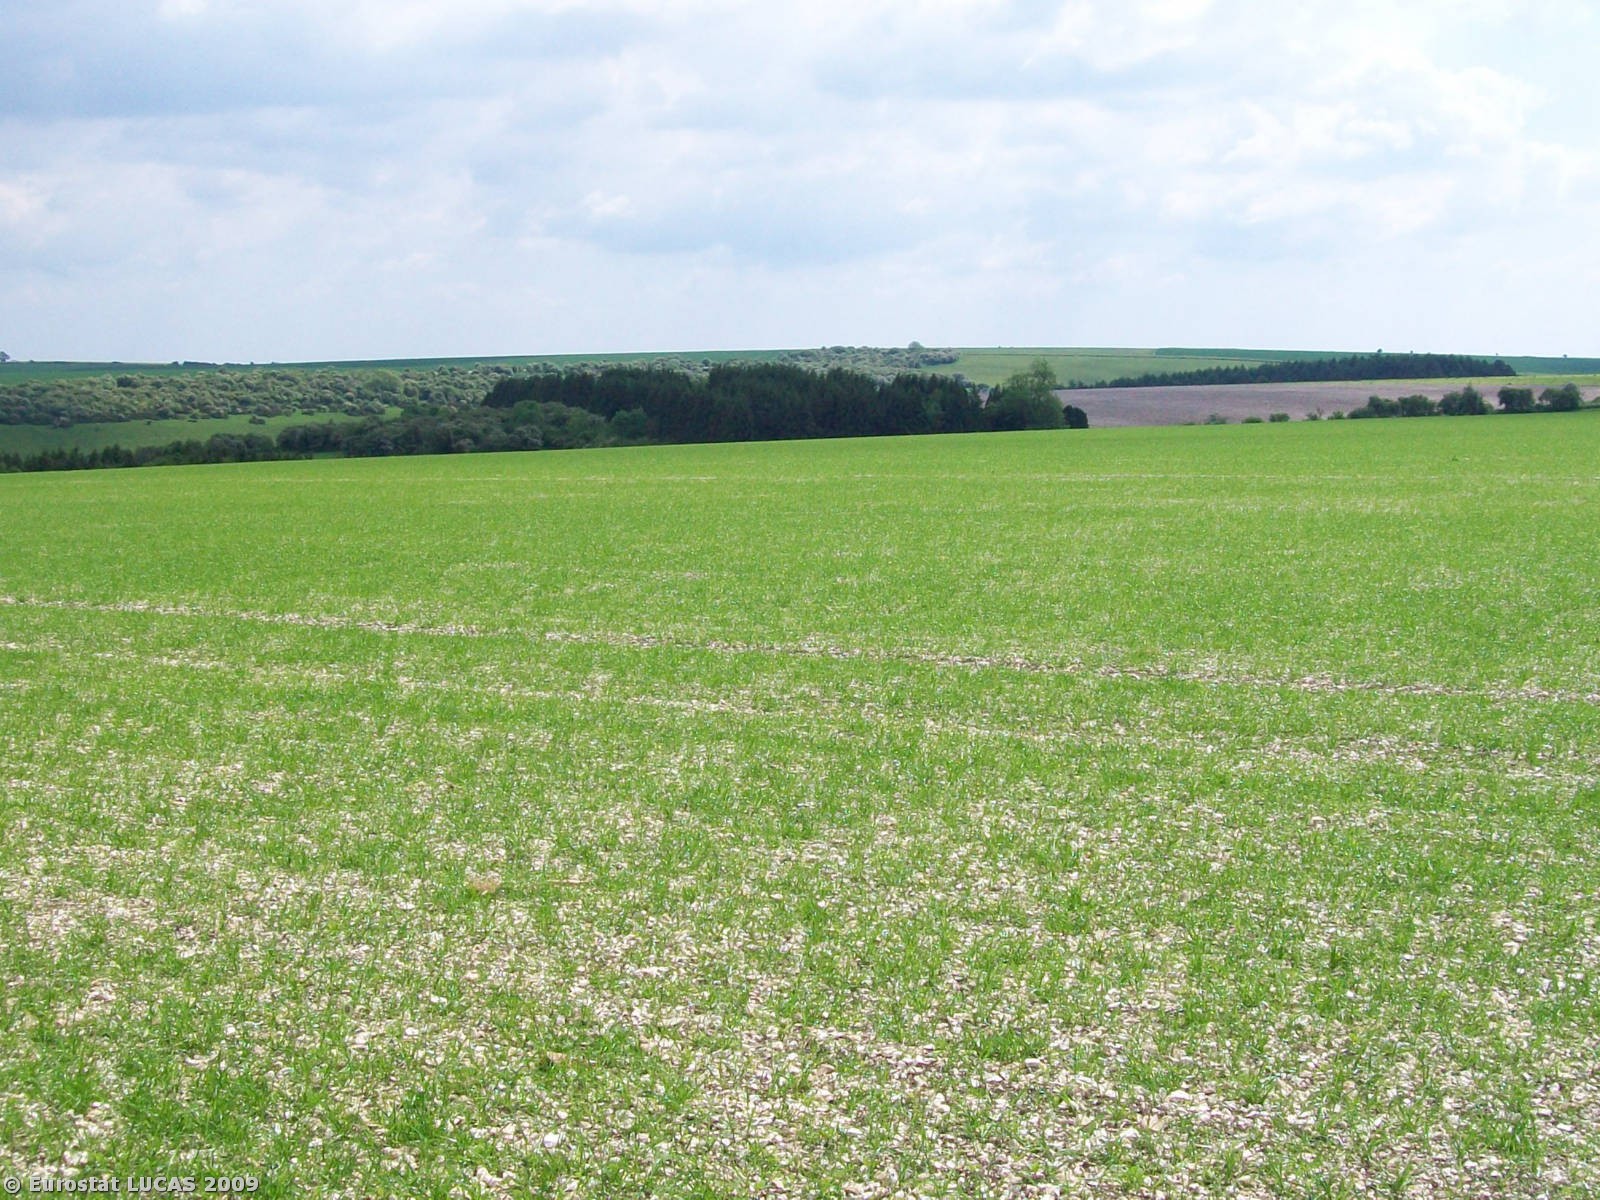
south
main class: Cropland
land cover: Barley
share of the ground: 50 - 75 %
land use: Agriculture (excluding fallow land and kitchen gardens)
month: May
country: GB
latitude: 51.1246
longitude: -2.2210
